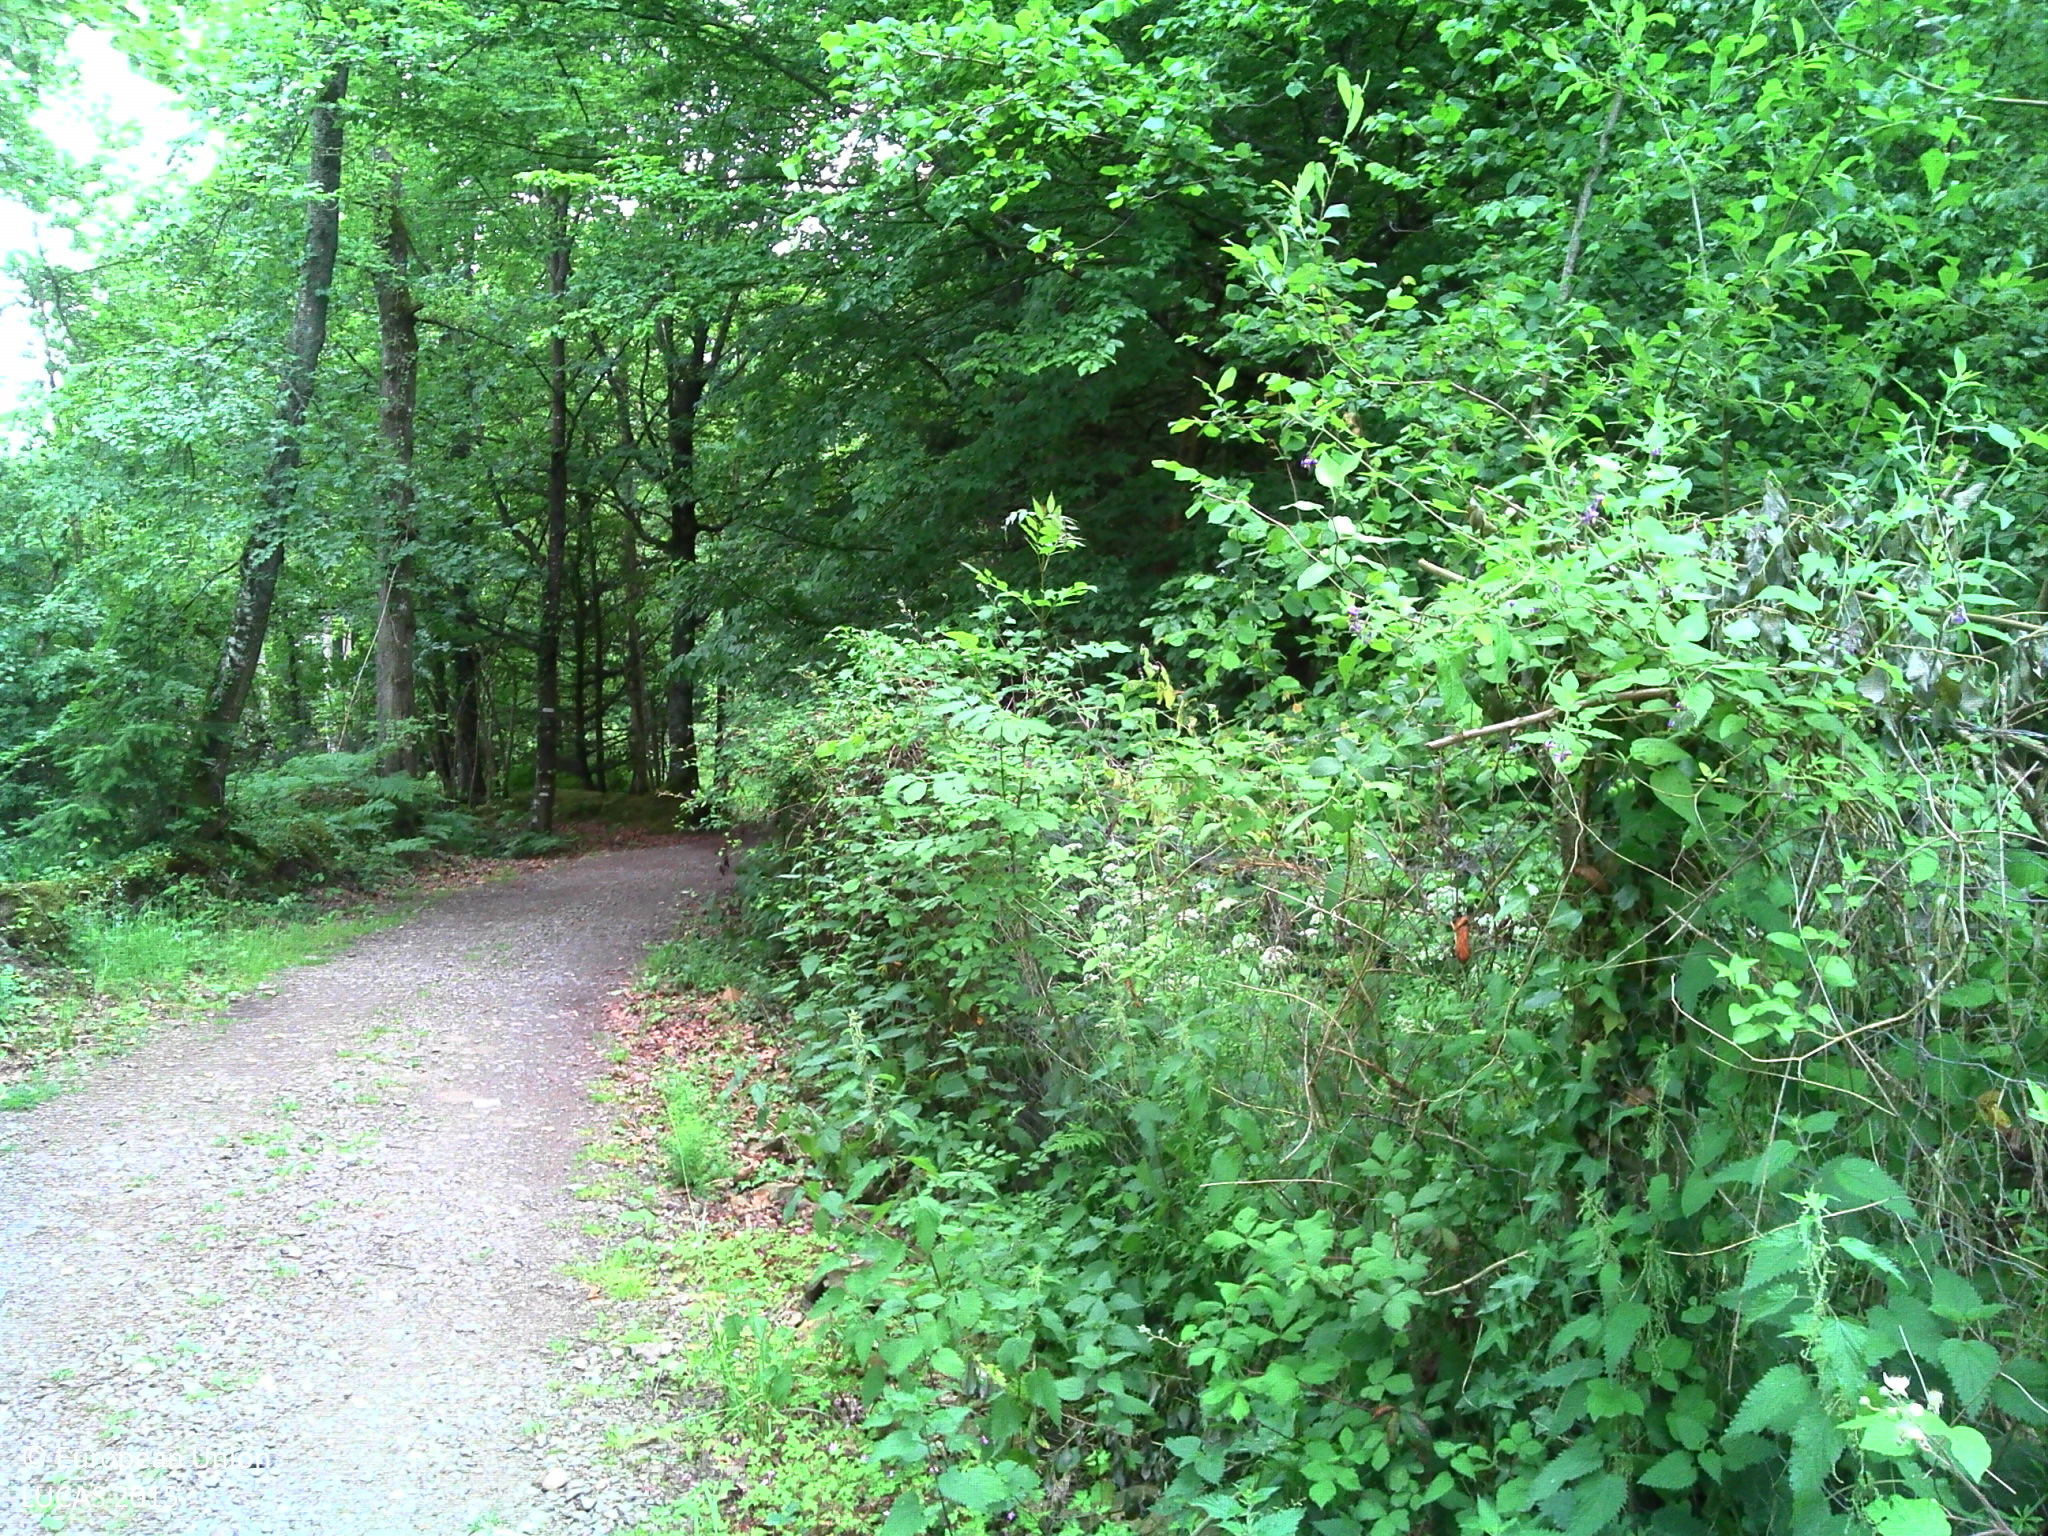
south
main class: Woodland
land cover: Spruce dominated mixed woodland
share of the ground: > 75 %
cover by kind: broadleaved forest trees 55 %, coniferous forest trees 40 %, herbaceous plants 5 %
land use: Semi-natural and natural areas not in use
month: June
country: FR
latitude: 48.4861
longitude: -1.7265
